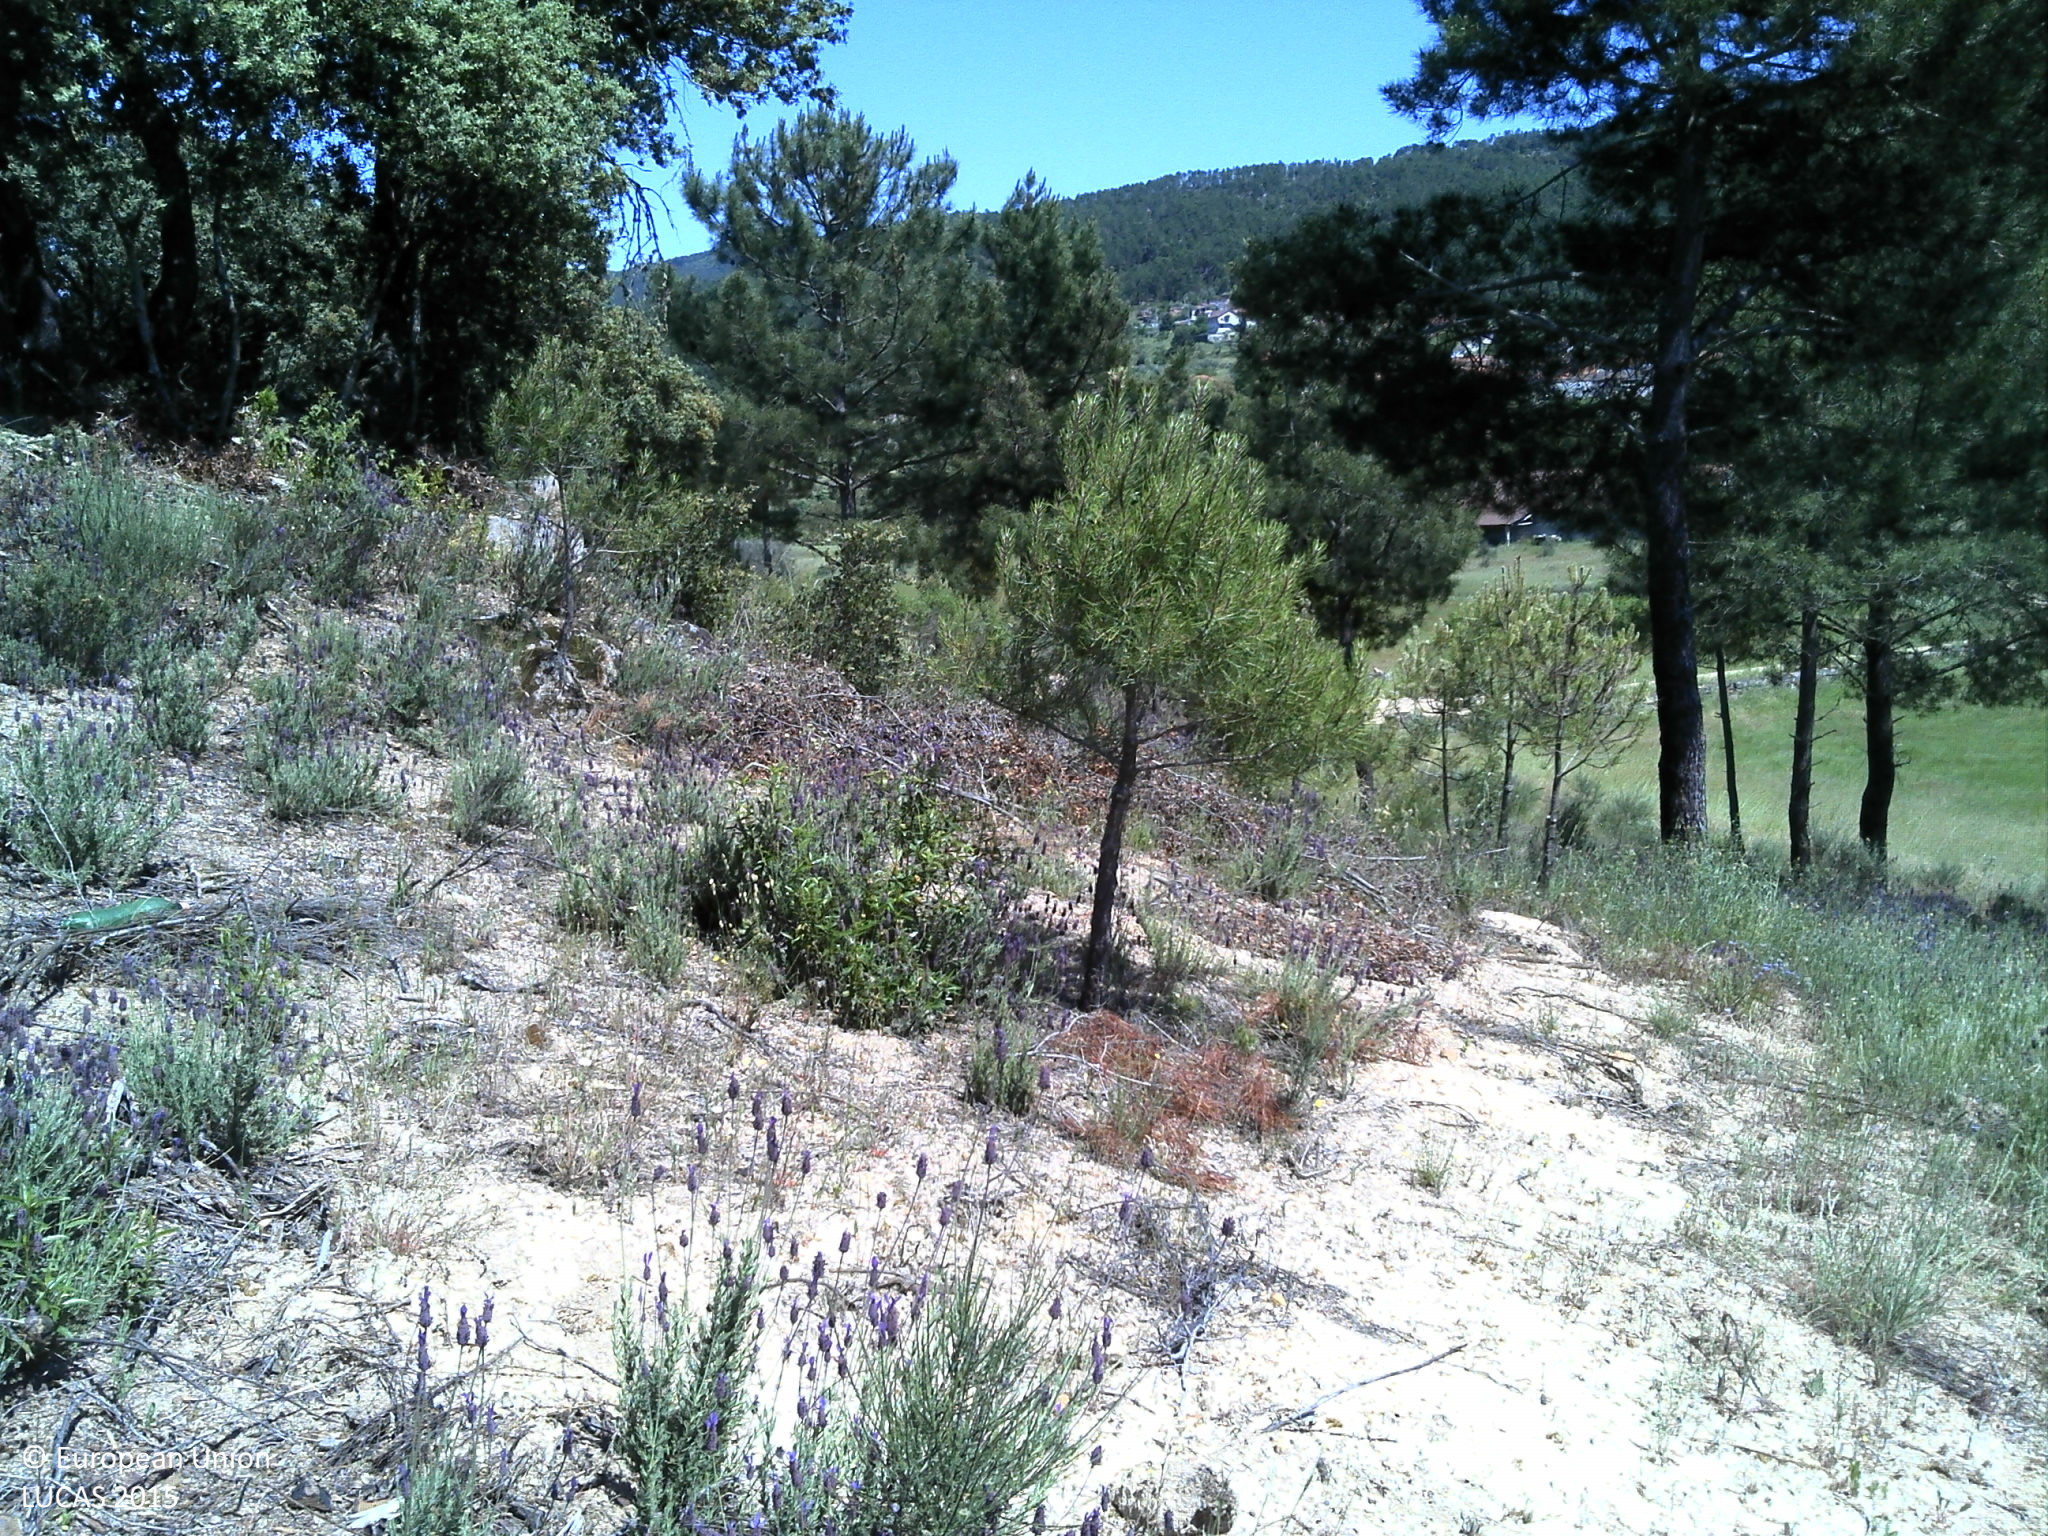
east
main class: Shrubland
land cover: Shrubland with sparse tree cover
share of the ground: 50 - 75 %
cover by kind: shrubs 65 %, unconsolidated bare surface 30 %, coniferous forest trees 5 %
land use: Forestry
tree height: > 5 m
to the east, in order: Shrubland with sparse tree cover; Shrubland without tree cover; Tracks; Pine dominated coniferous woodland; Abandoned hedges; Dry stone walls; Ditches and canals; Grassland without tree/shrub cover; Dry stone walls; Abandoned hedges; Grassland without tree/shrub cover; Dry stone walls; Grassland without tree/shrub cover; Abandoned hedges; Shrubland with sparse tree cover; Grassland without tree/shrub cover
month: May
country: PT
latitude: 41.6070
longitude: -7.5409
